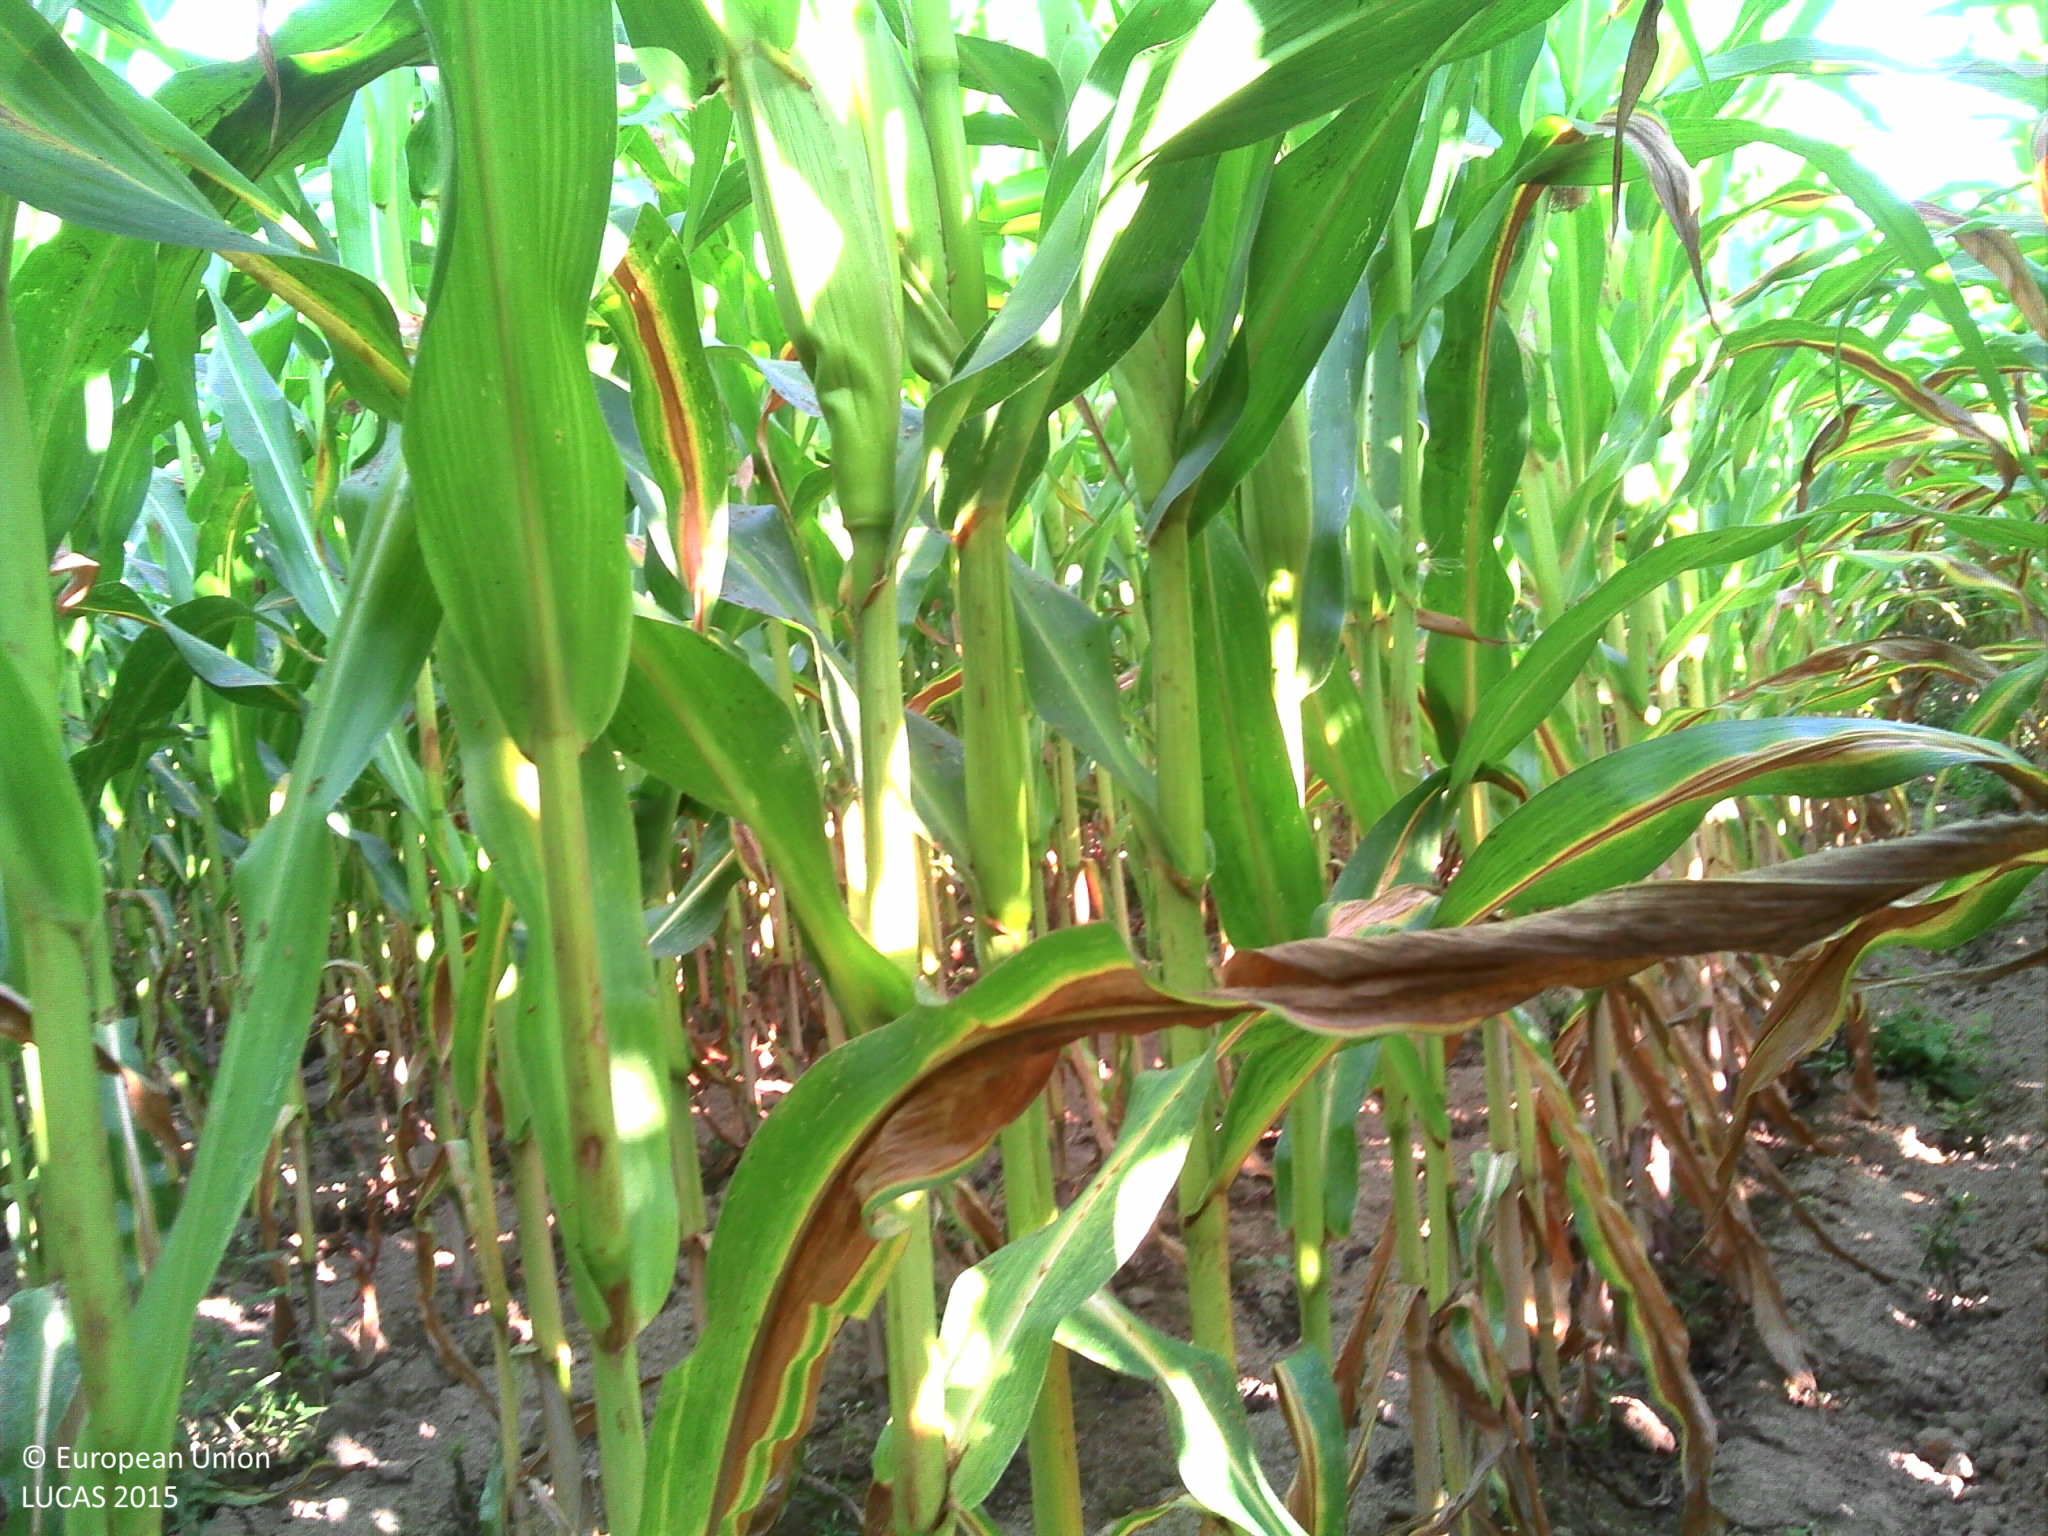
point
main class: Cropland
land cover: Maize
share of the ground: > 75 %
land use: Agriculture (excluding fallow land and kitchen gardens)
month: August
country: FR
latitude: 48.3155
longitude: -1.9599
